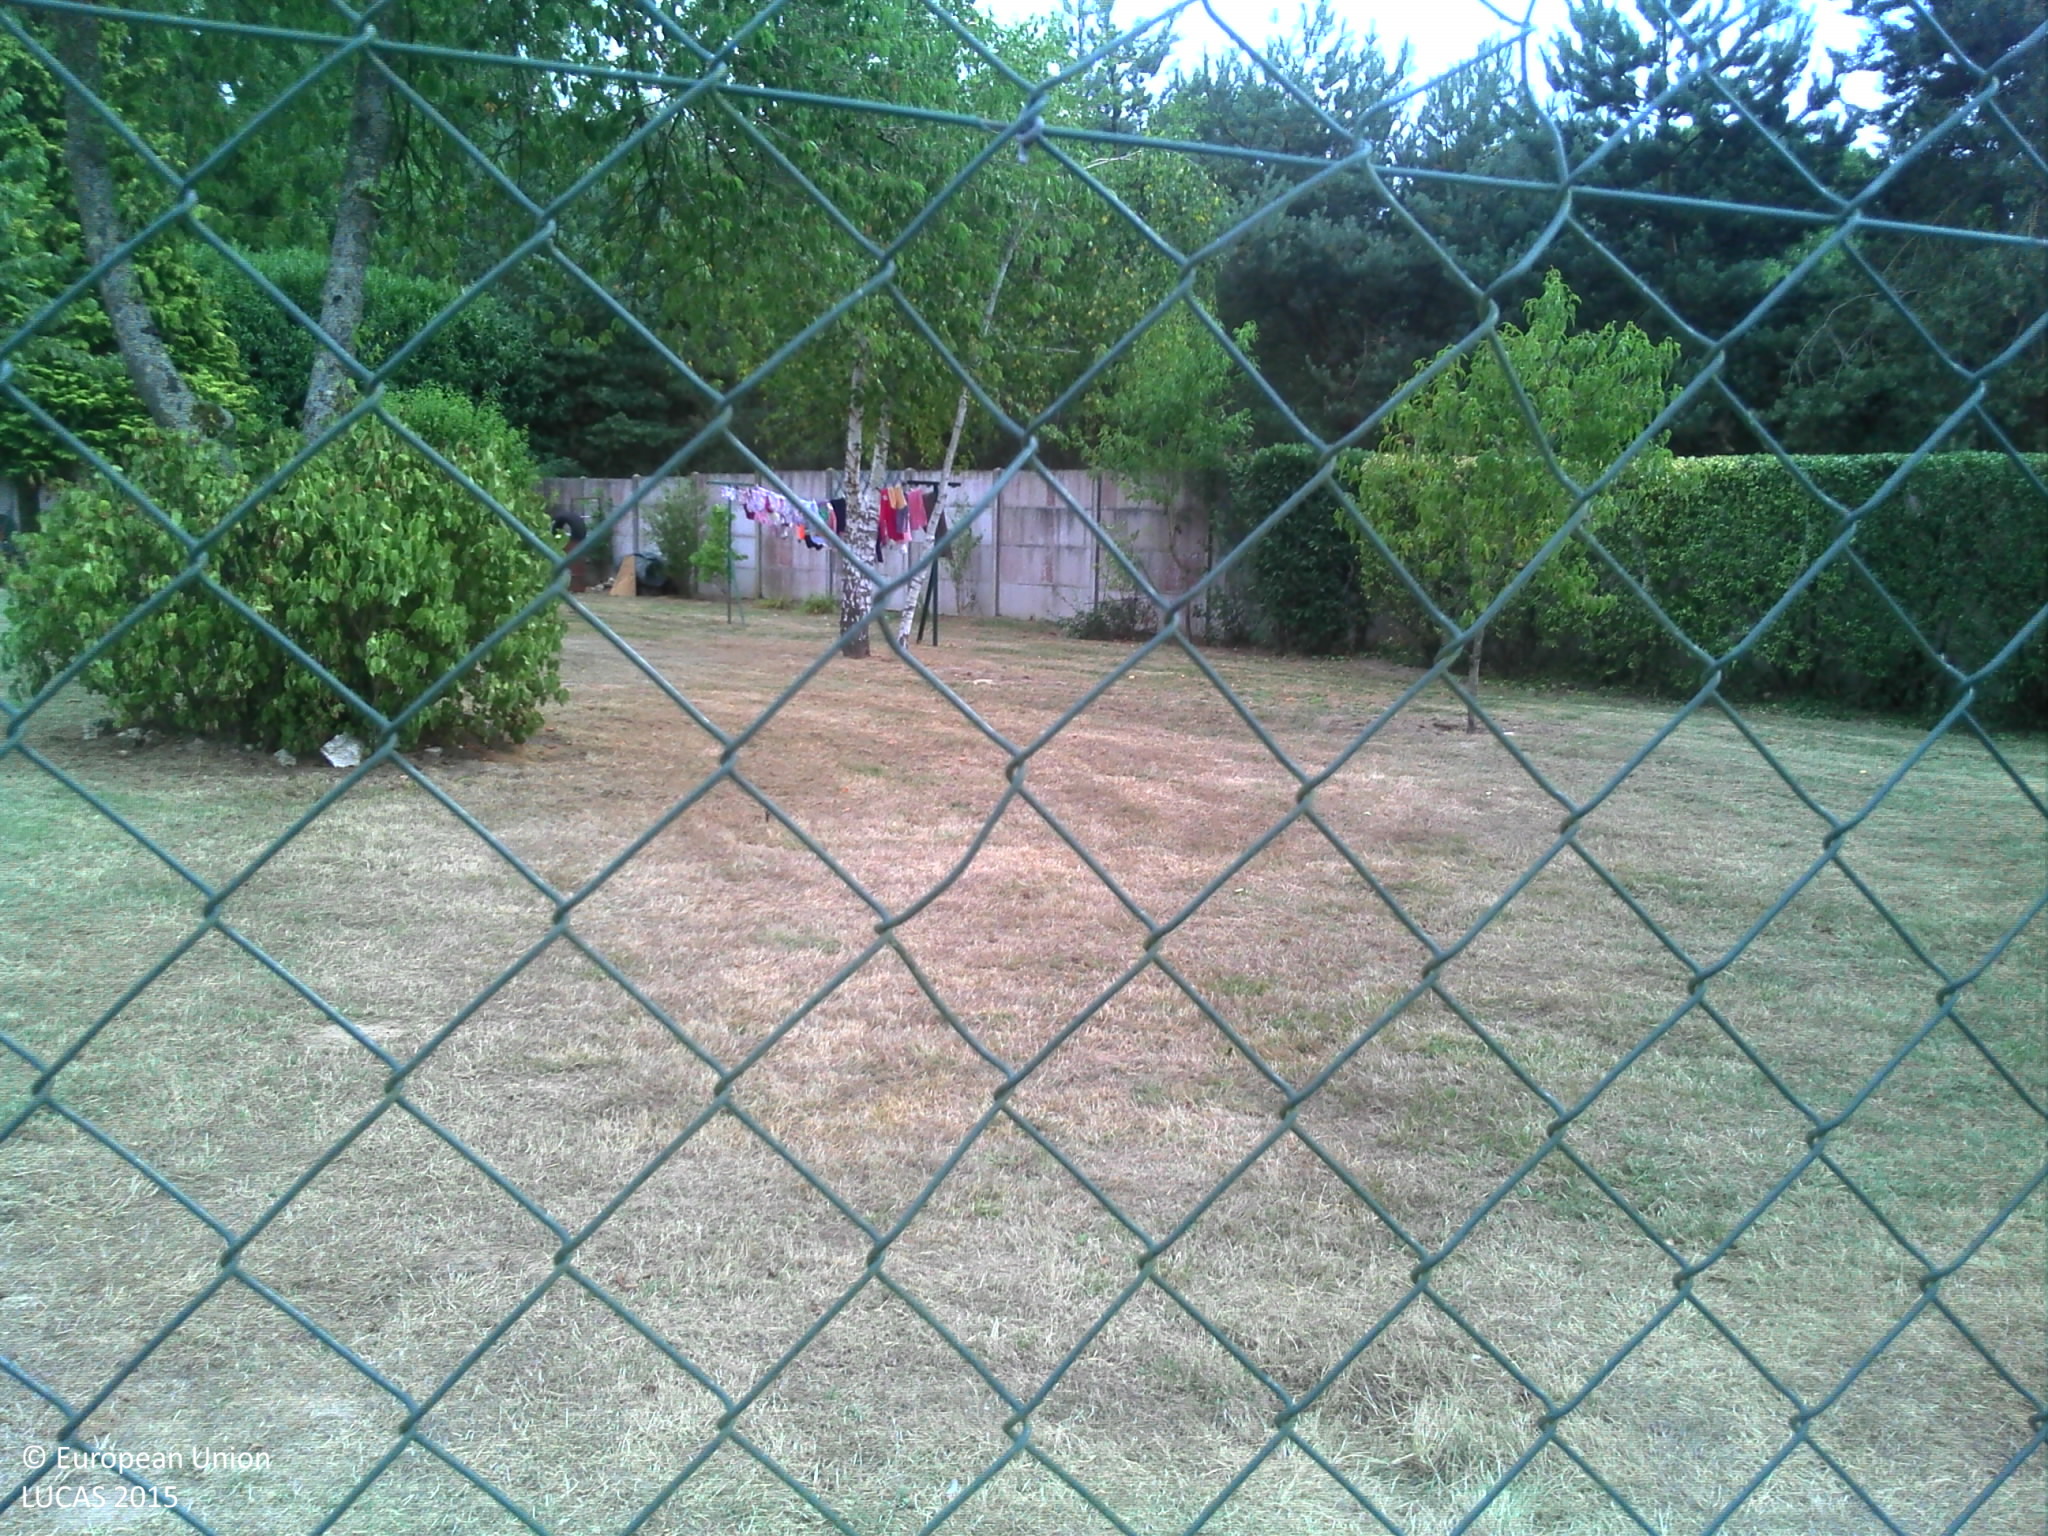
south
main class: Grassland
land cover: Grassland with sparse tree/shrub cover
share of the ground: > 75 %
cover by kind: herbaceous plants 95 %, broadleaved forest trees 5 %
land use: Residential
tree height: > 5 m
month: August
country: FR
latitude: 48.0434
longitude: 2.0334
